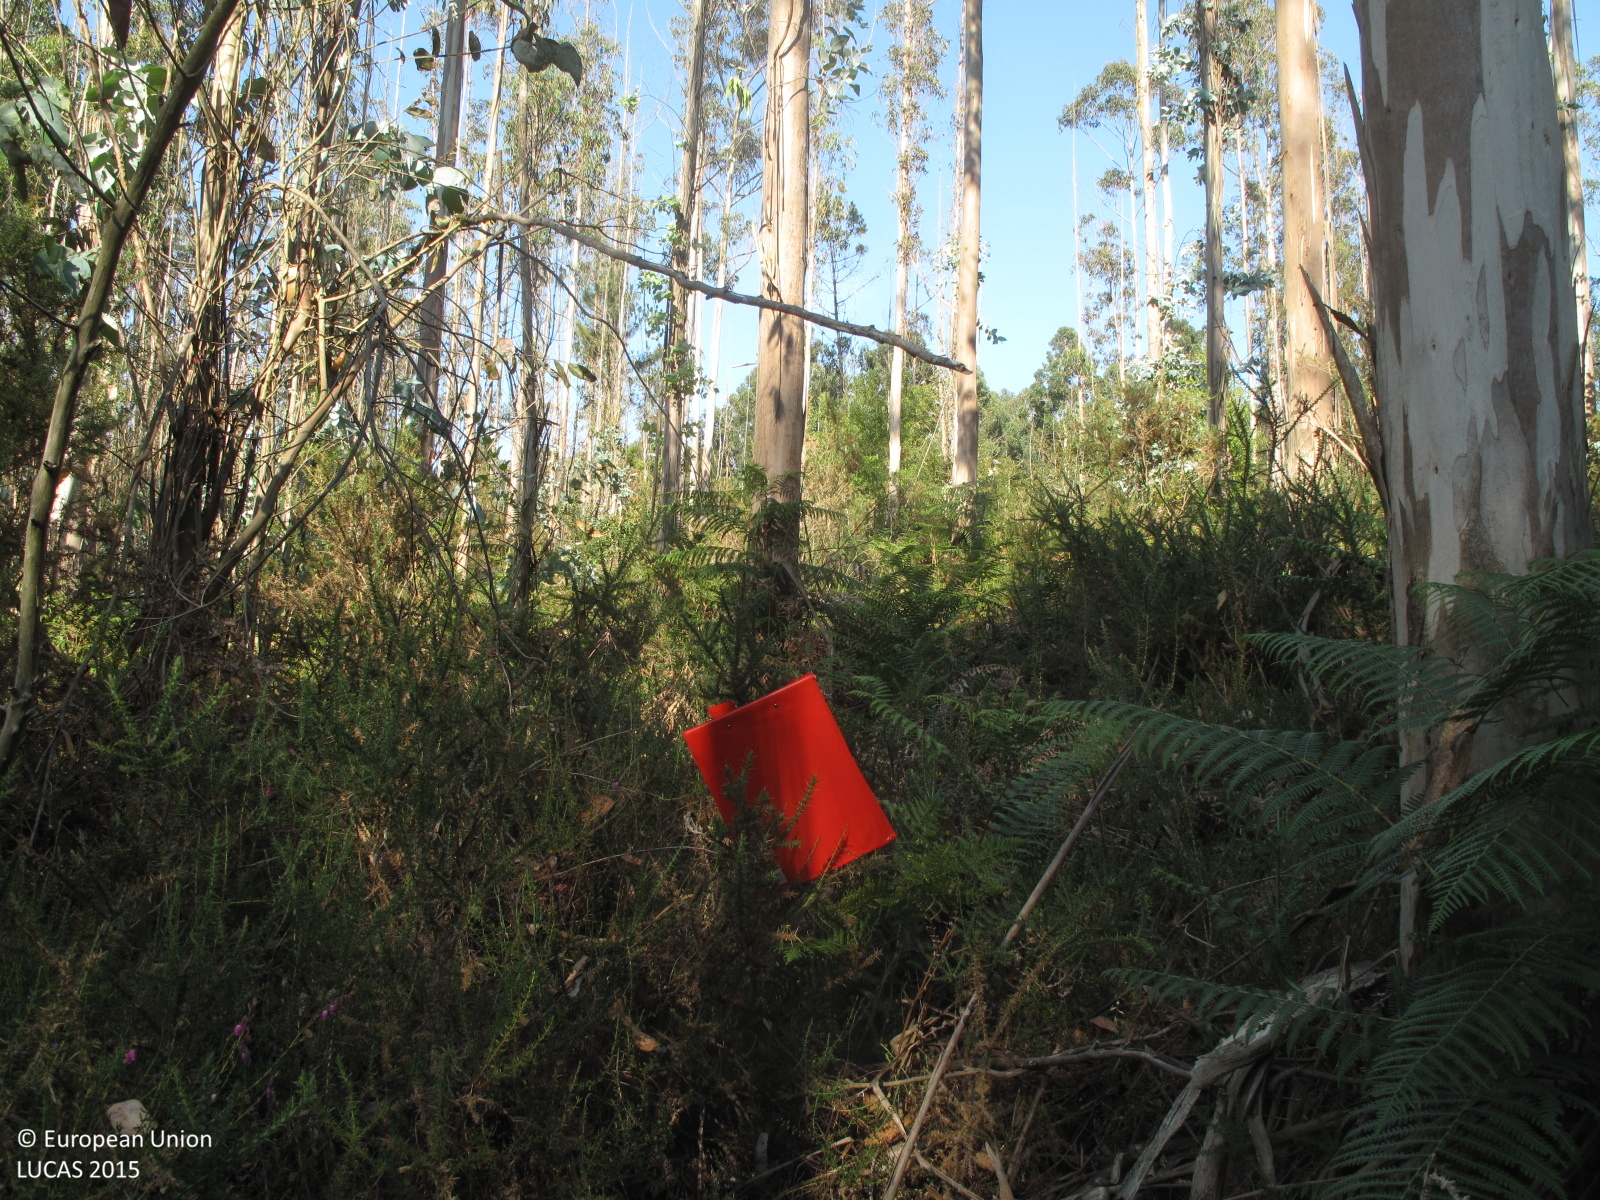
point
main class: Woodland
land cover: Broadleaved woodland
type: exotic forest
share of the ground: 25 - 50 %
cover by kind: shrubs 60 %, broadleaved forest trees 30 %, herbaceous plants 10 %
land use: Forestry
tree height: > 5 m
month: July
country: ES
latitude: 43.3169
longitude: -8.0863
